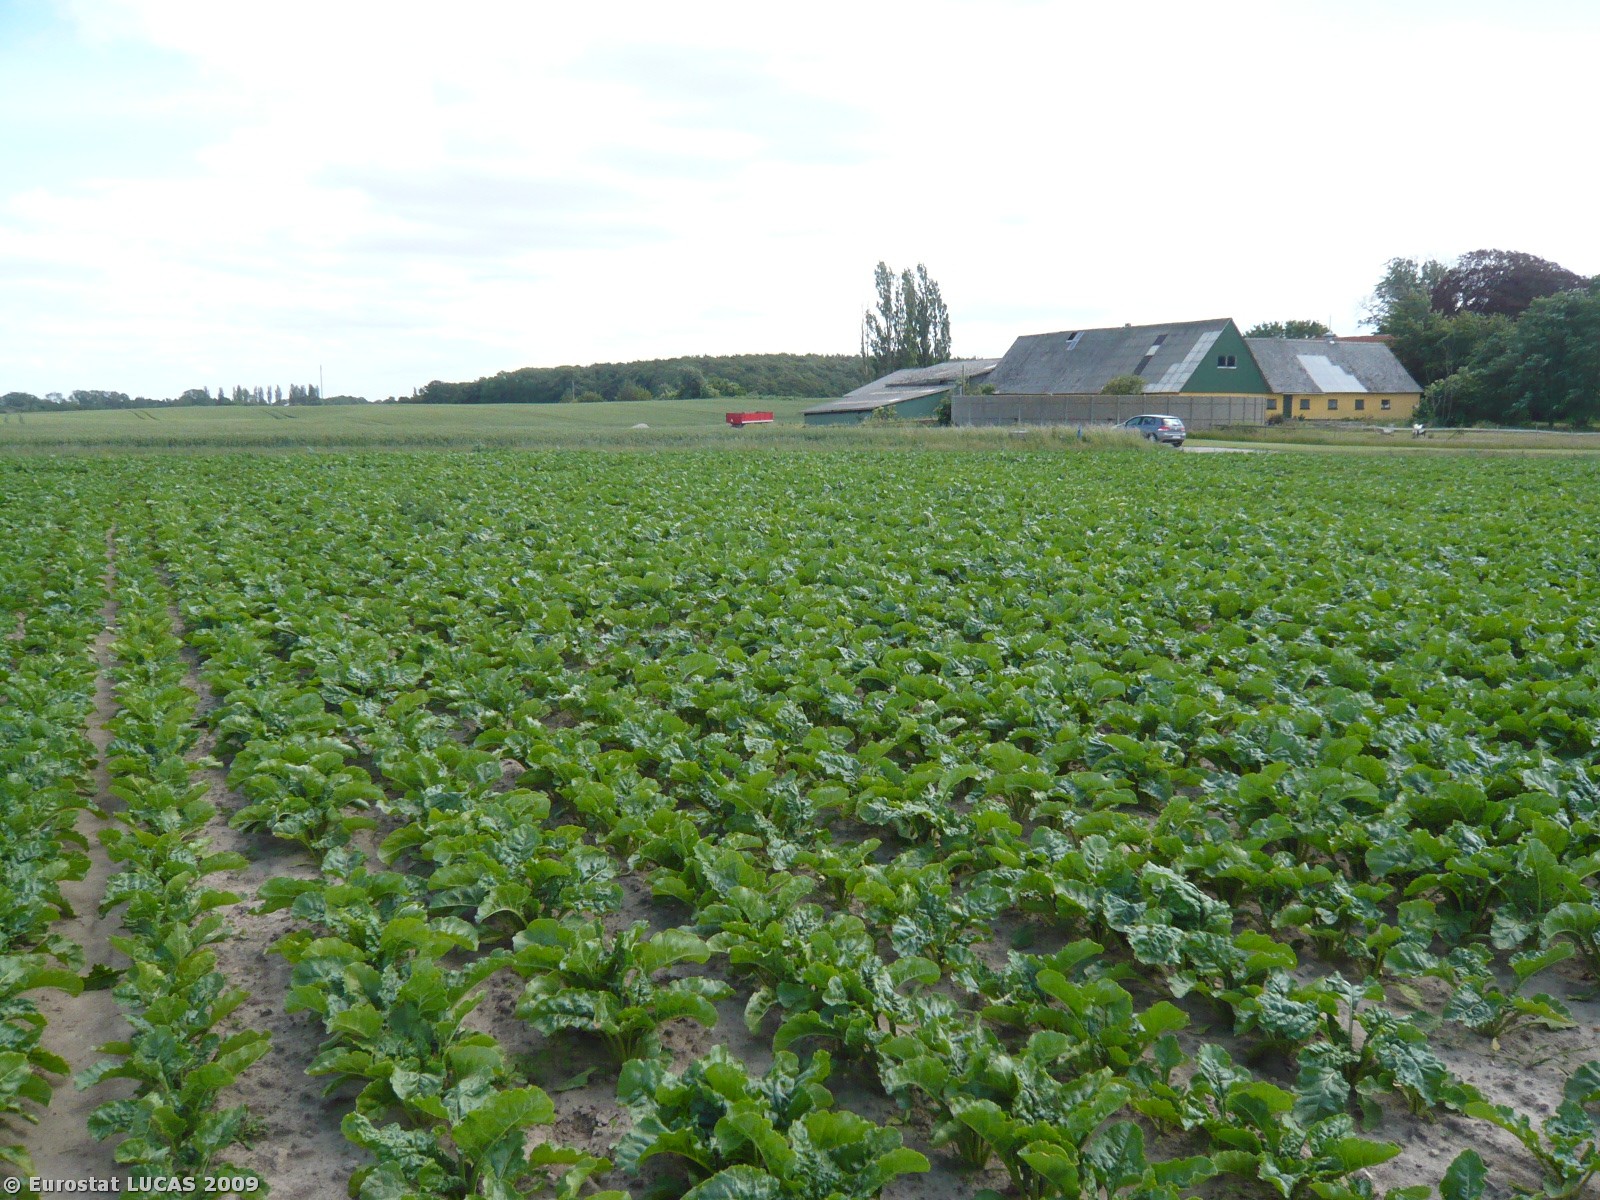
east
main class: Cropland
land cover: Sugar beet
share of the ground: > 75 %
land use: Agriculture (excluding fallow land and kitchen gardens)
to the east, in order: Sugar beet; Grass margins; Paved roads, cycling and walking lanes; Grass margins; Common wheat
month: June
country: DK
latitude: 54.8869
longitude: 11.2930
